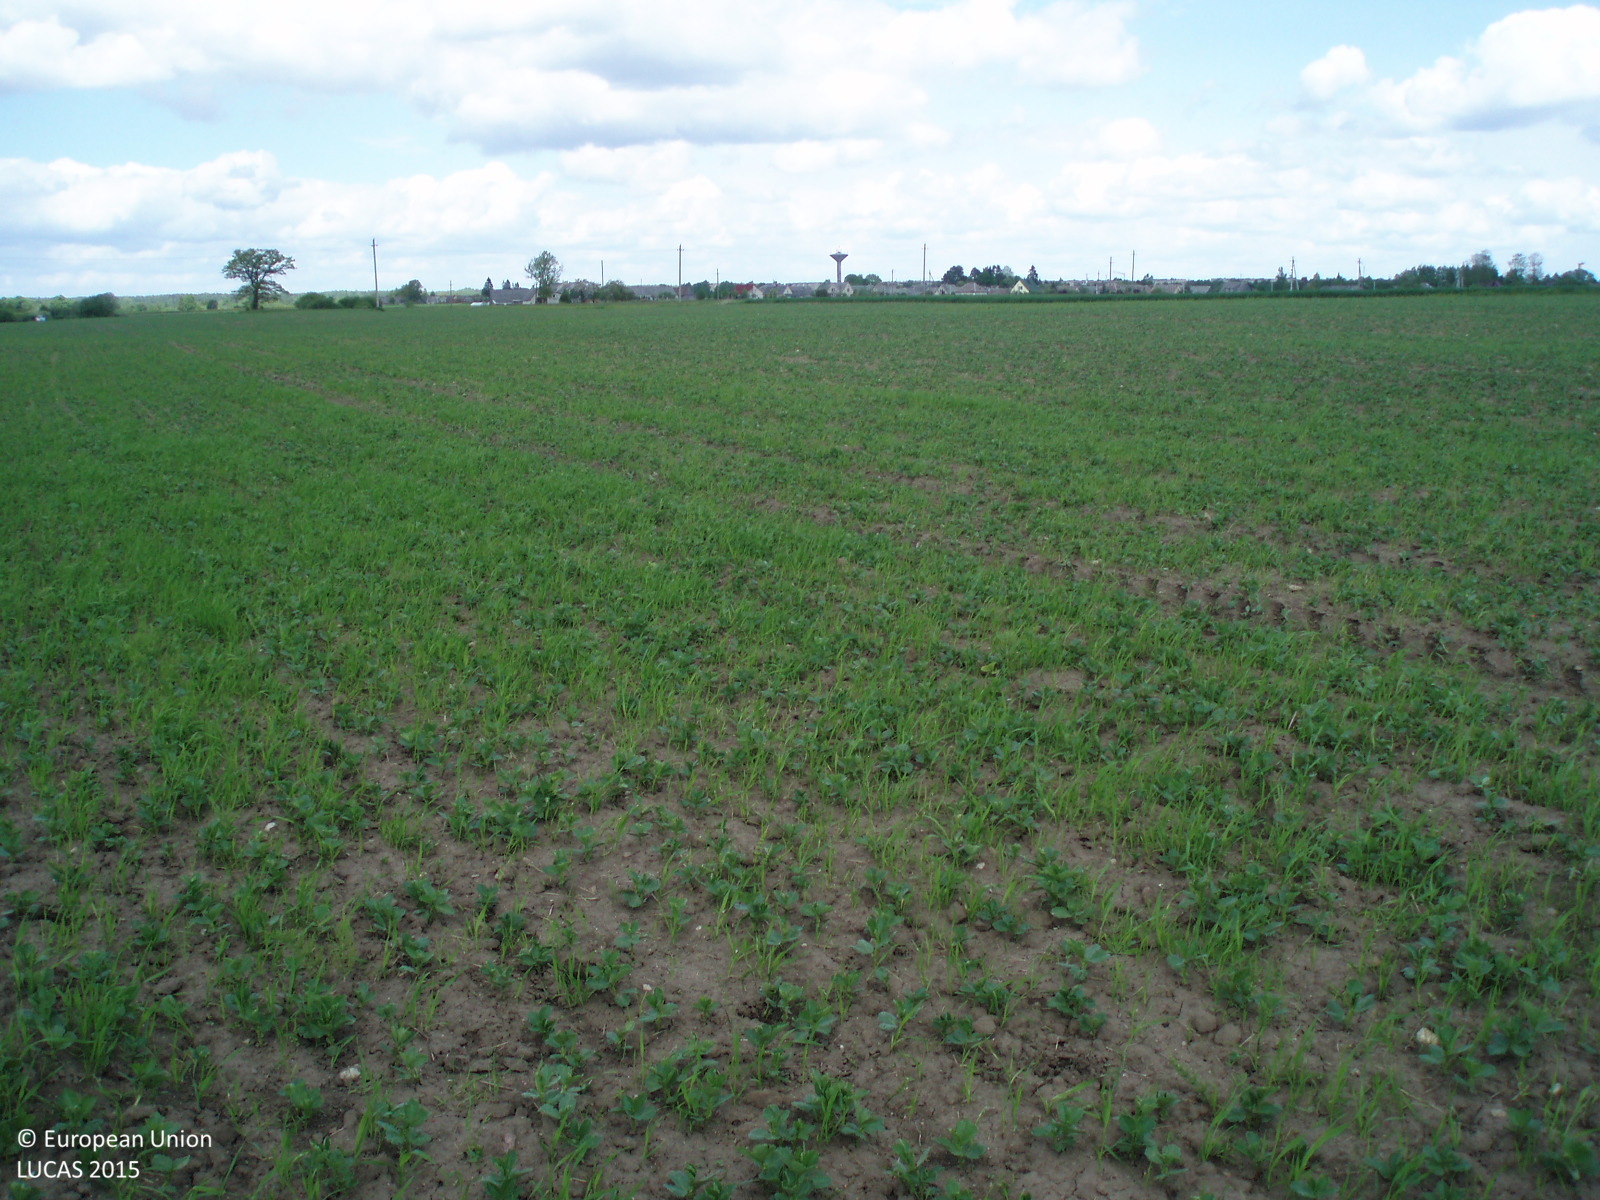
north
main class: Cropland
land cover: Dry pulses
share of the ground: 50 - 75 %
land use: Agriculture (excluding fallow land and kitchen gardens)
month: May
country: LT
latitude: 56.1758
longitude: 22.6740
